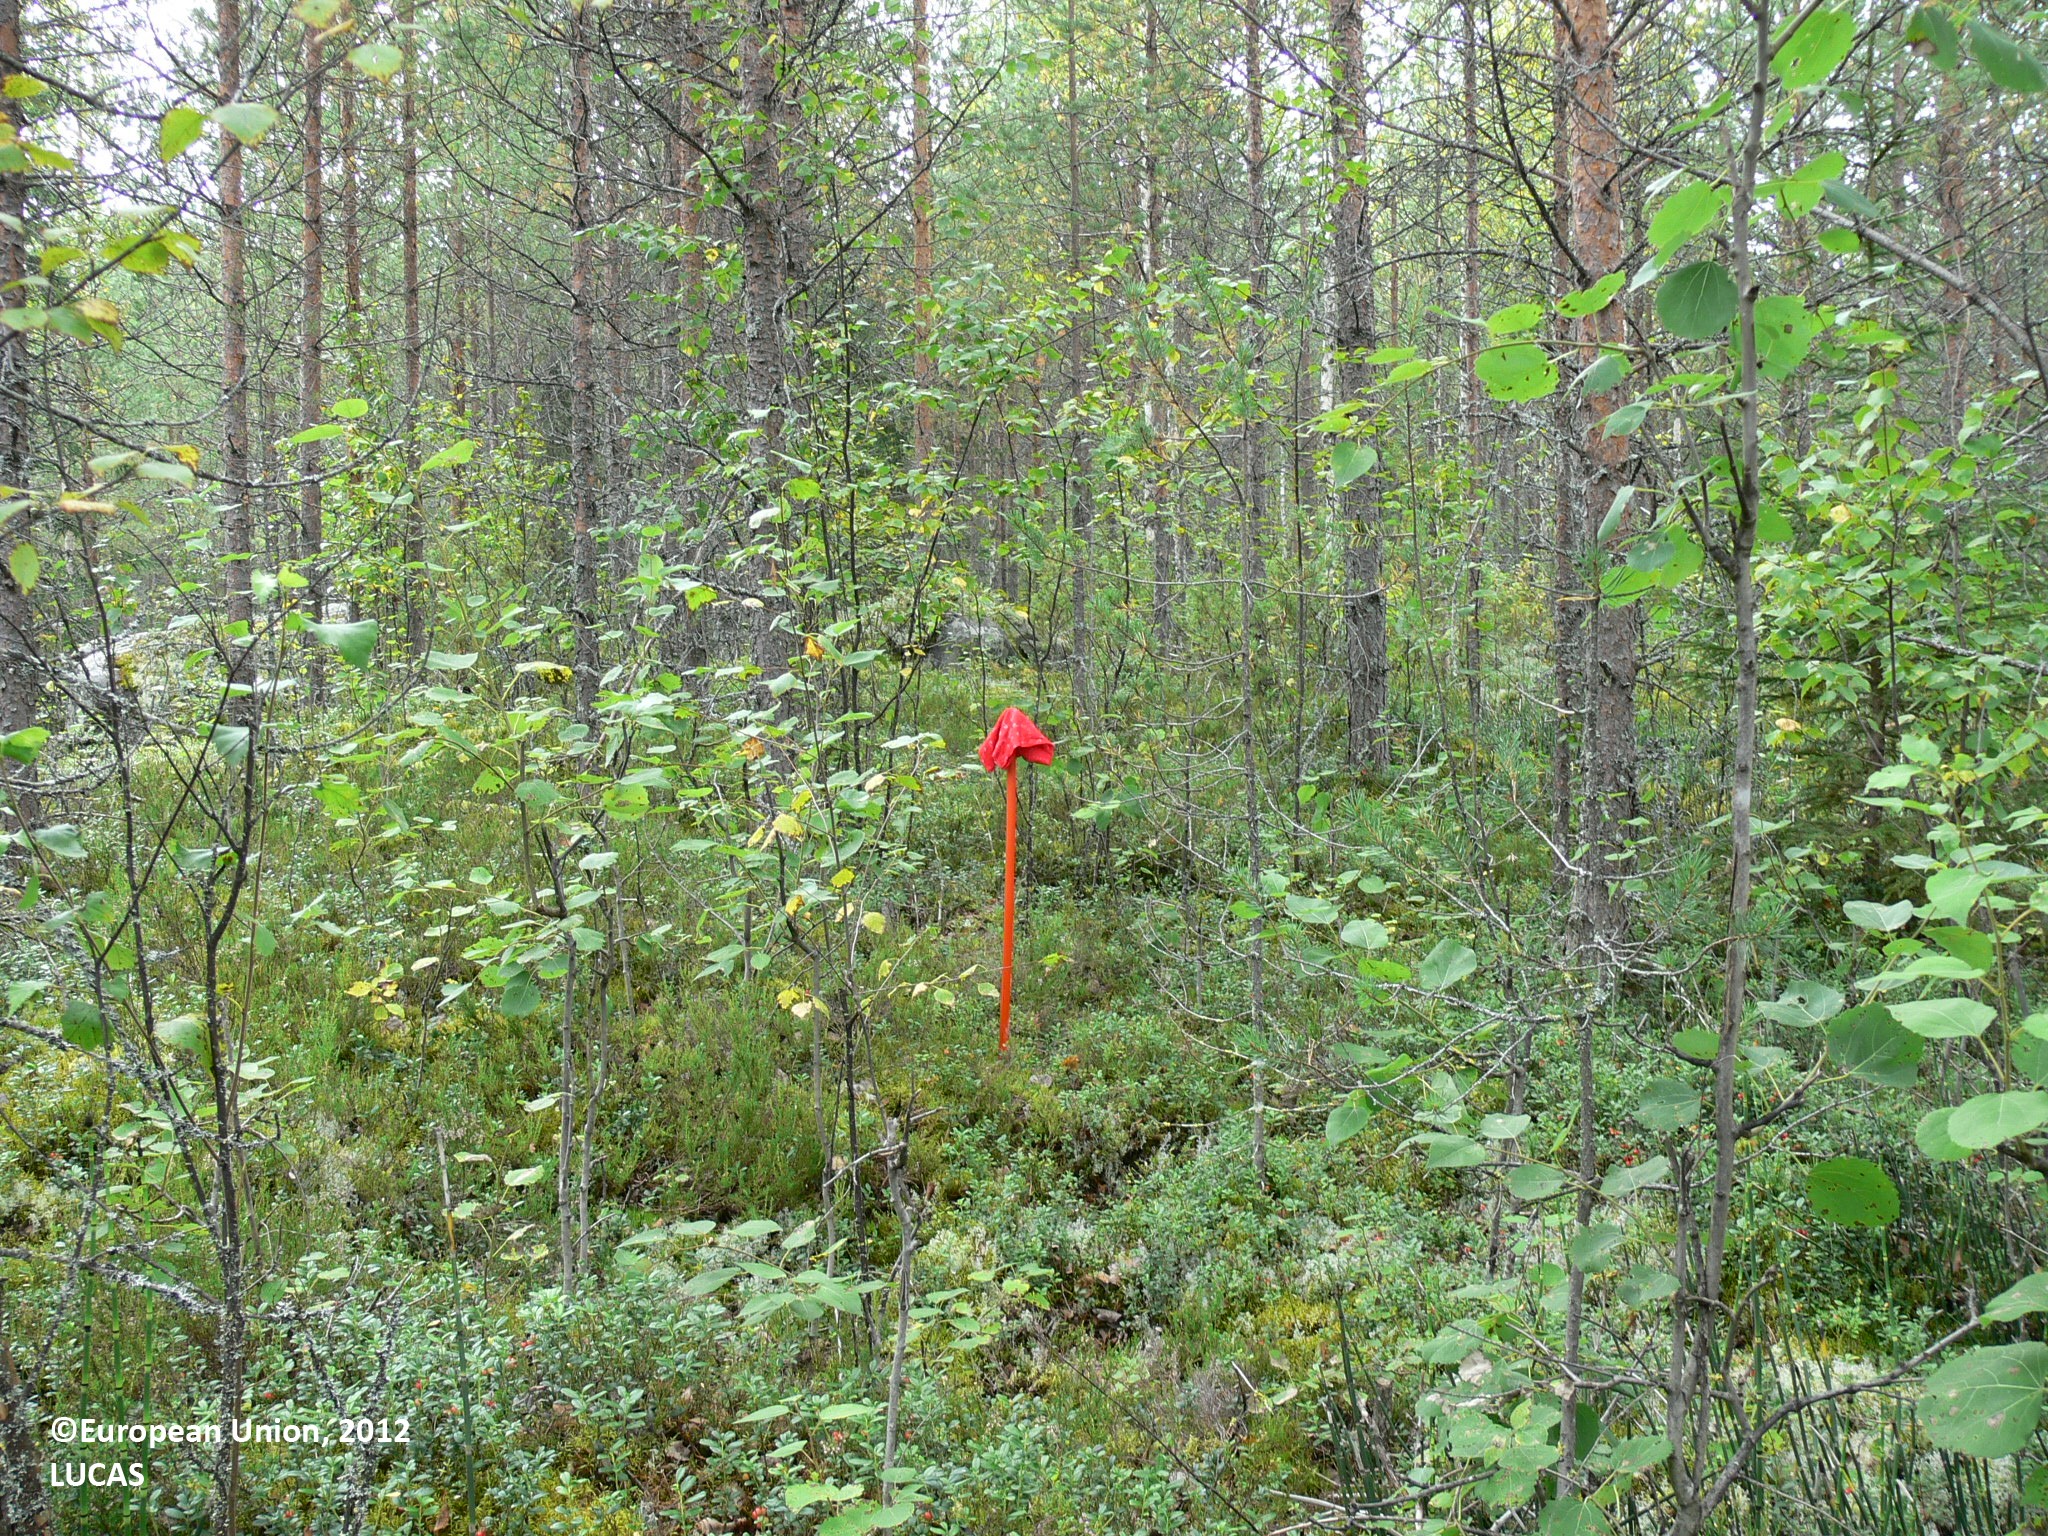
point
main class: Woodland
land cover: Other mixed woodland
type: boreal forest
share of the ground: > 75 %
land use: Forestry
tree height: > 5 m
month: August
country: FI
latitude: 63.2861
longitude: 30.3025
